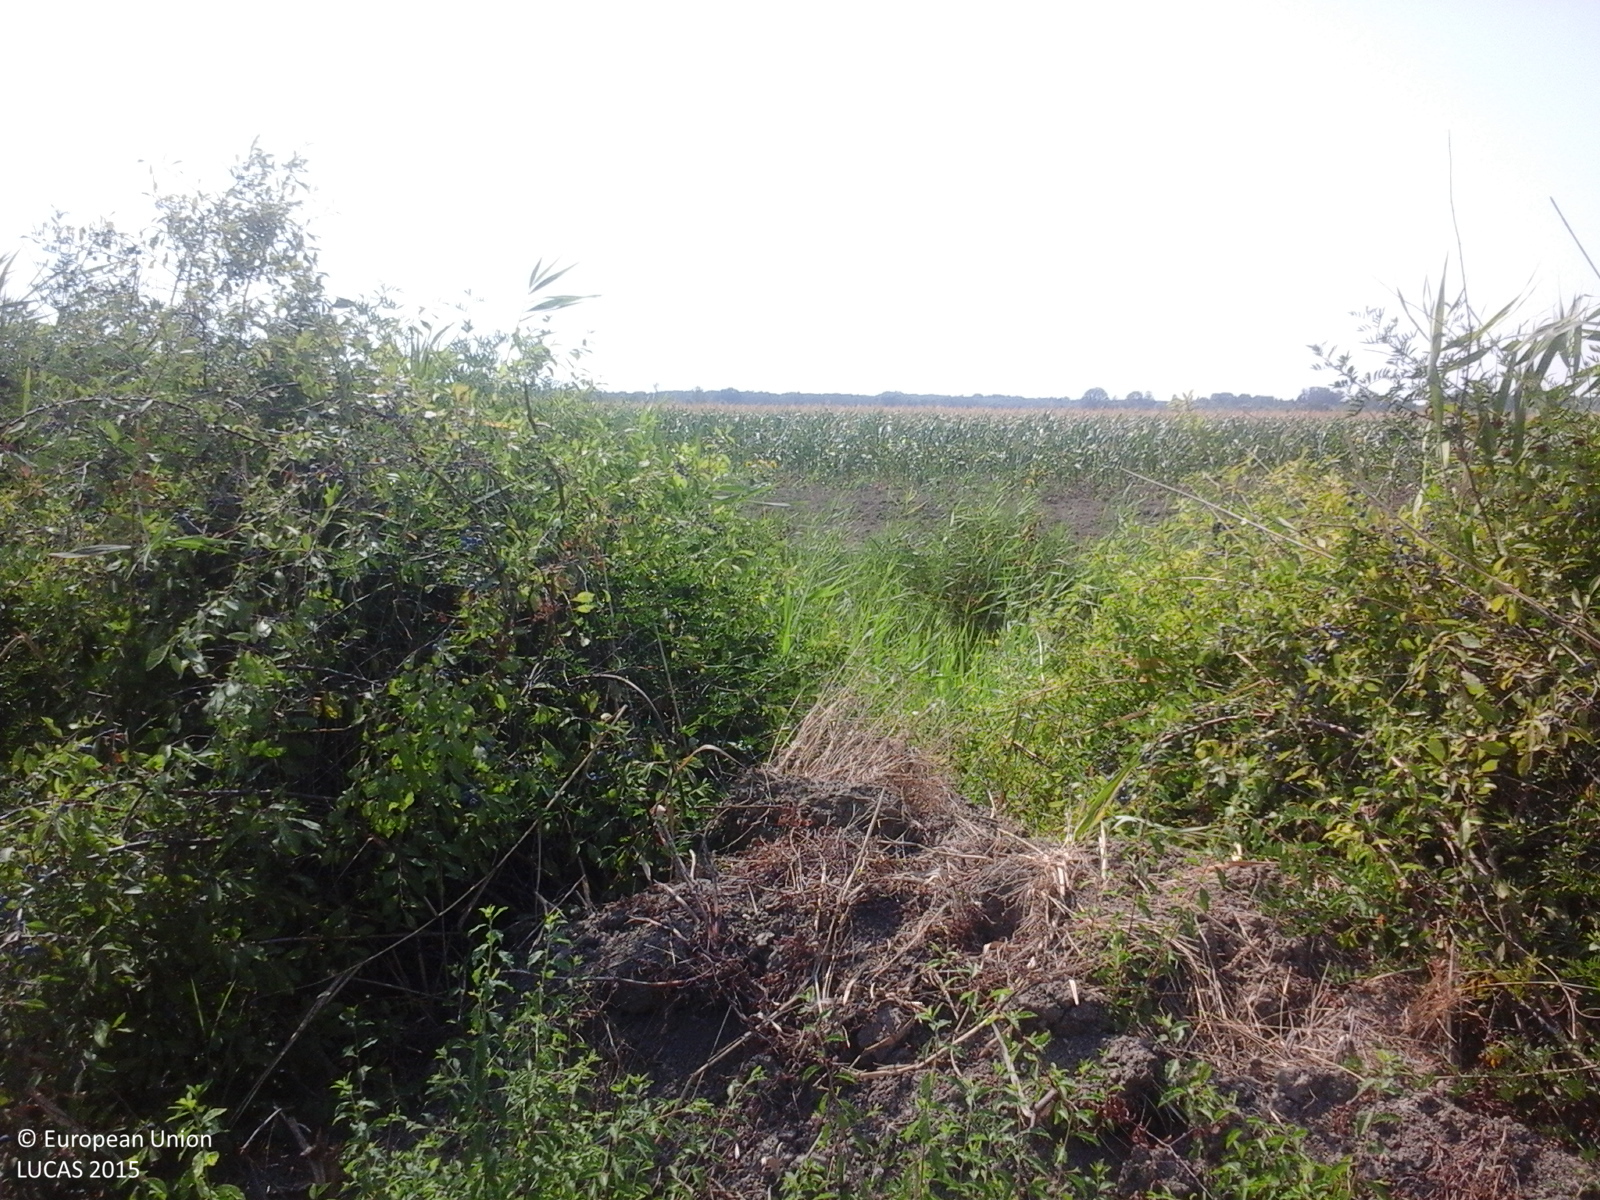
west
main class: Cropland
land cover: Sunflower
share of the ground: > 75 %
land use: Agriculture (excluding fallow land and kitchen gardens)
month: July
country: RO
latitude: 45.4124
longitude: 27.8082
